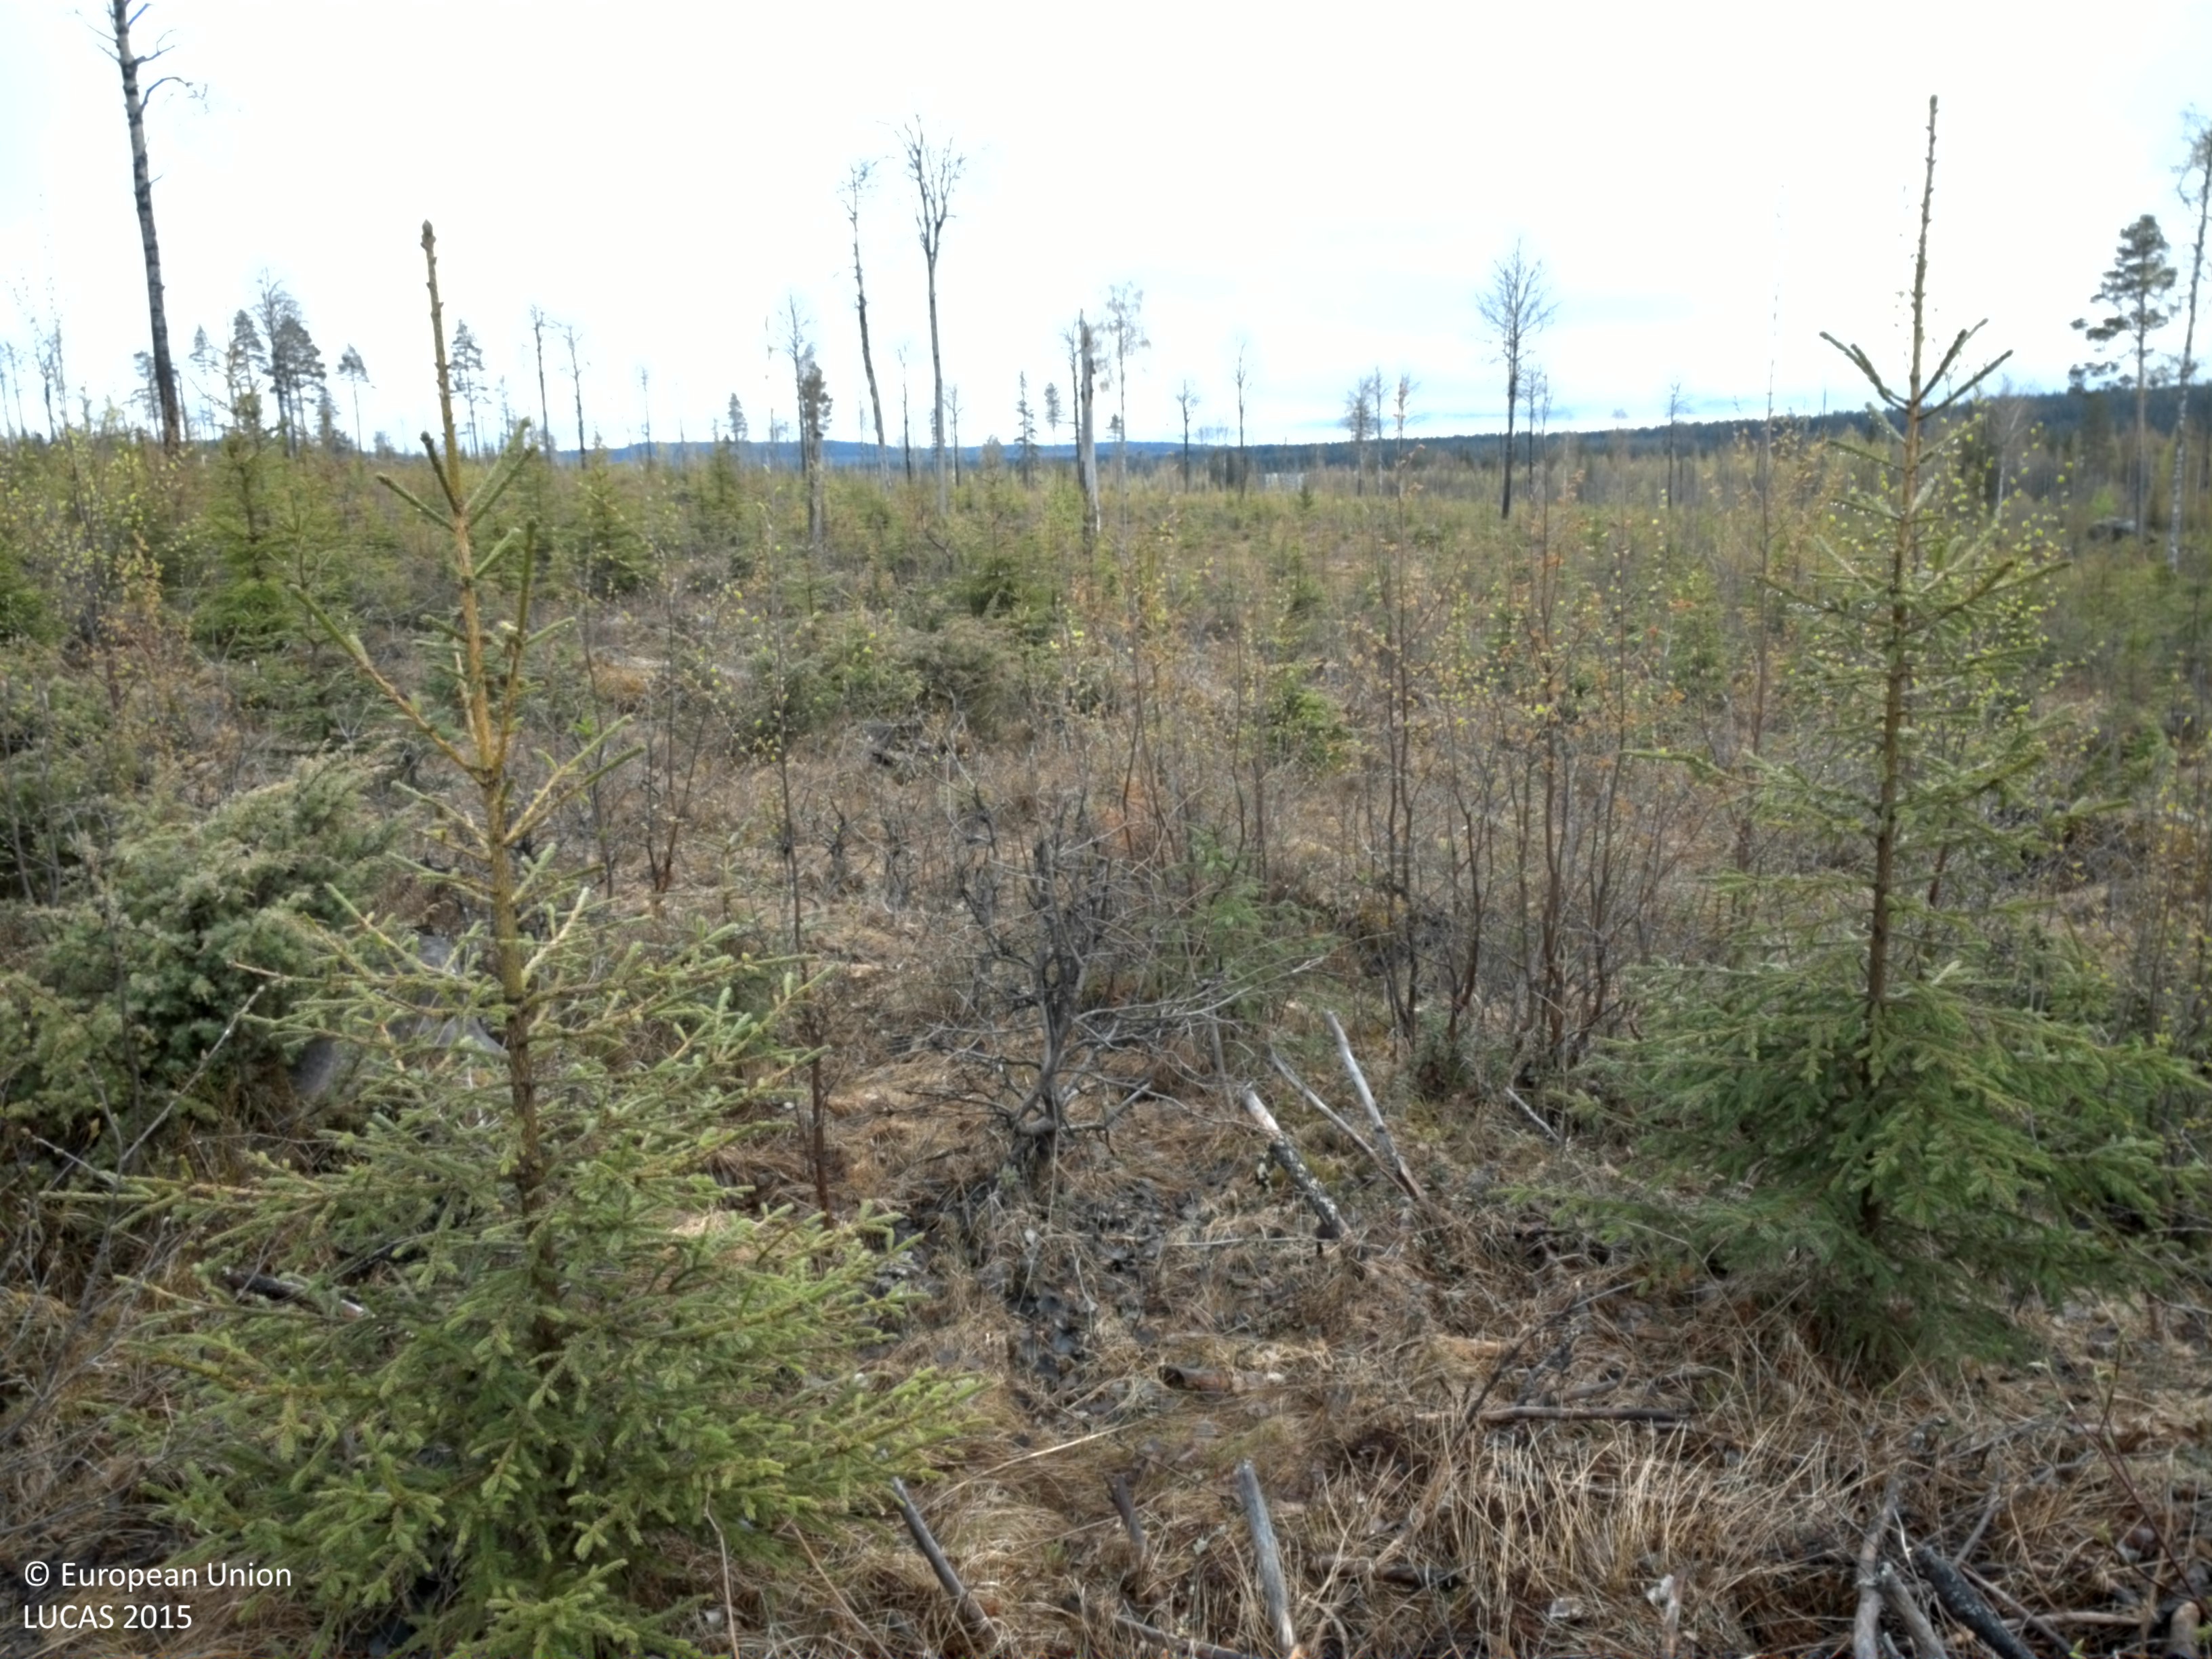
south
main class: Woodland
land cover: Spruce dominated mixed woodland
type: boreal forest
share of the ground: > 75 %
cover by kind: broadleaved forest trees 40 %, coniferous forest trees 35 %, herbaceous plants 15 %, shrubs 10 %
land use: Forestry
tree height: < 5 m
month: May
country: SE
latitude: 66.2648
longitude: 23.2760
